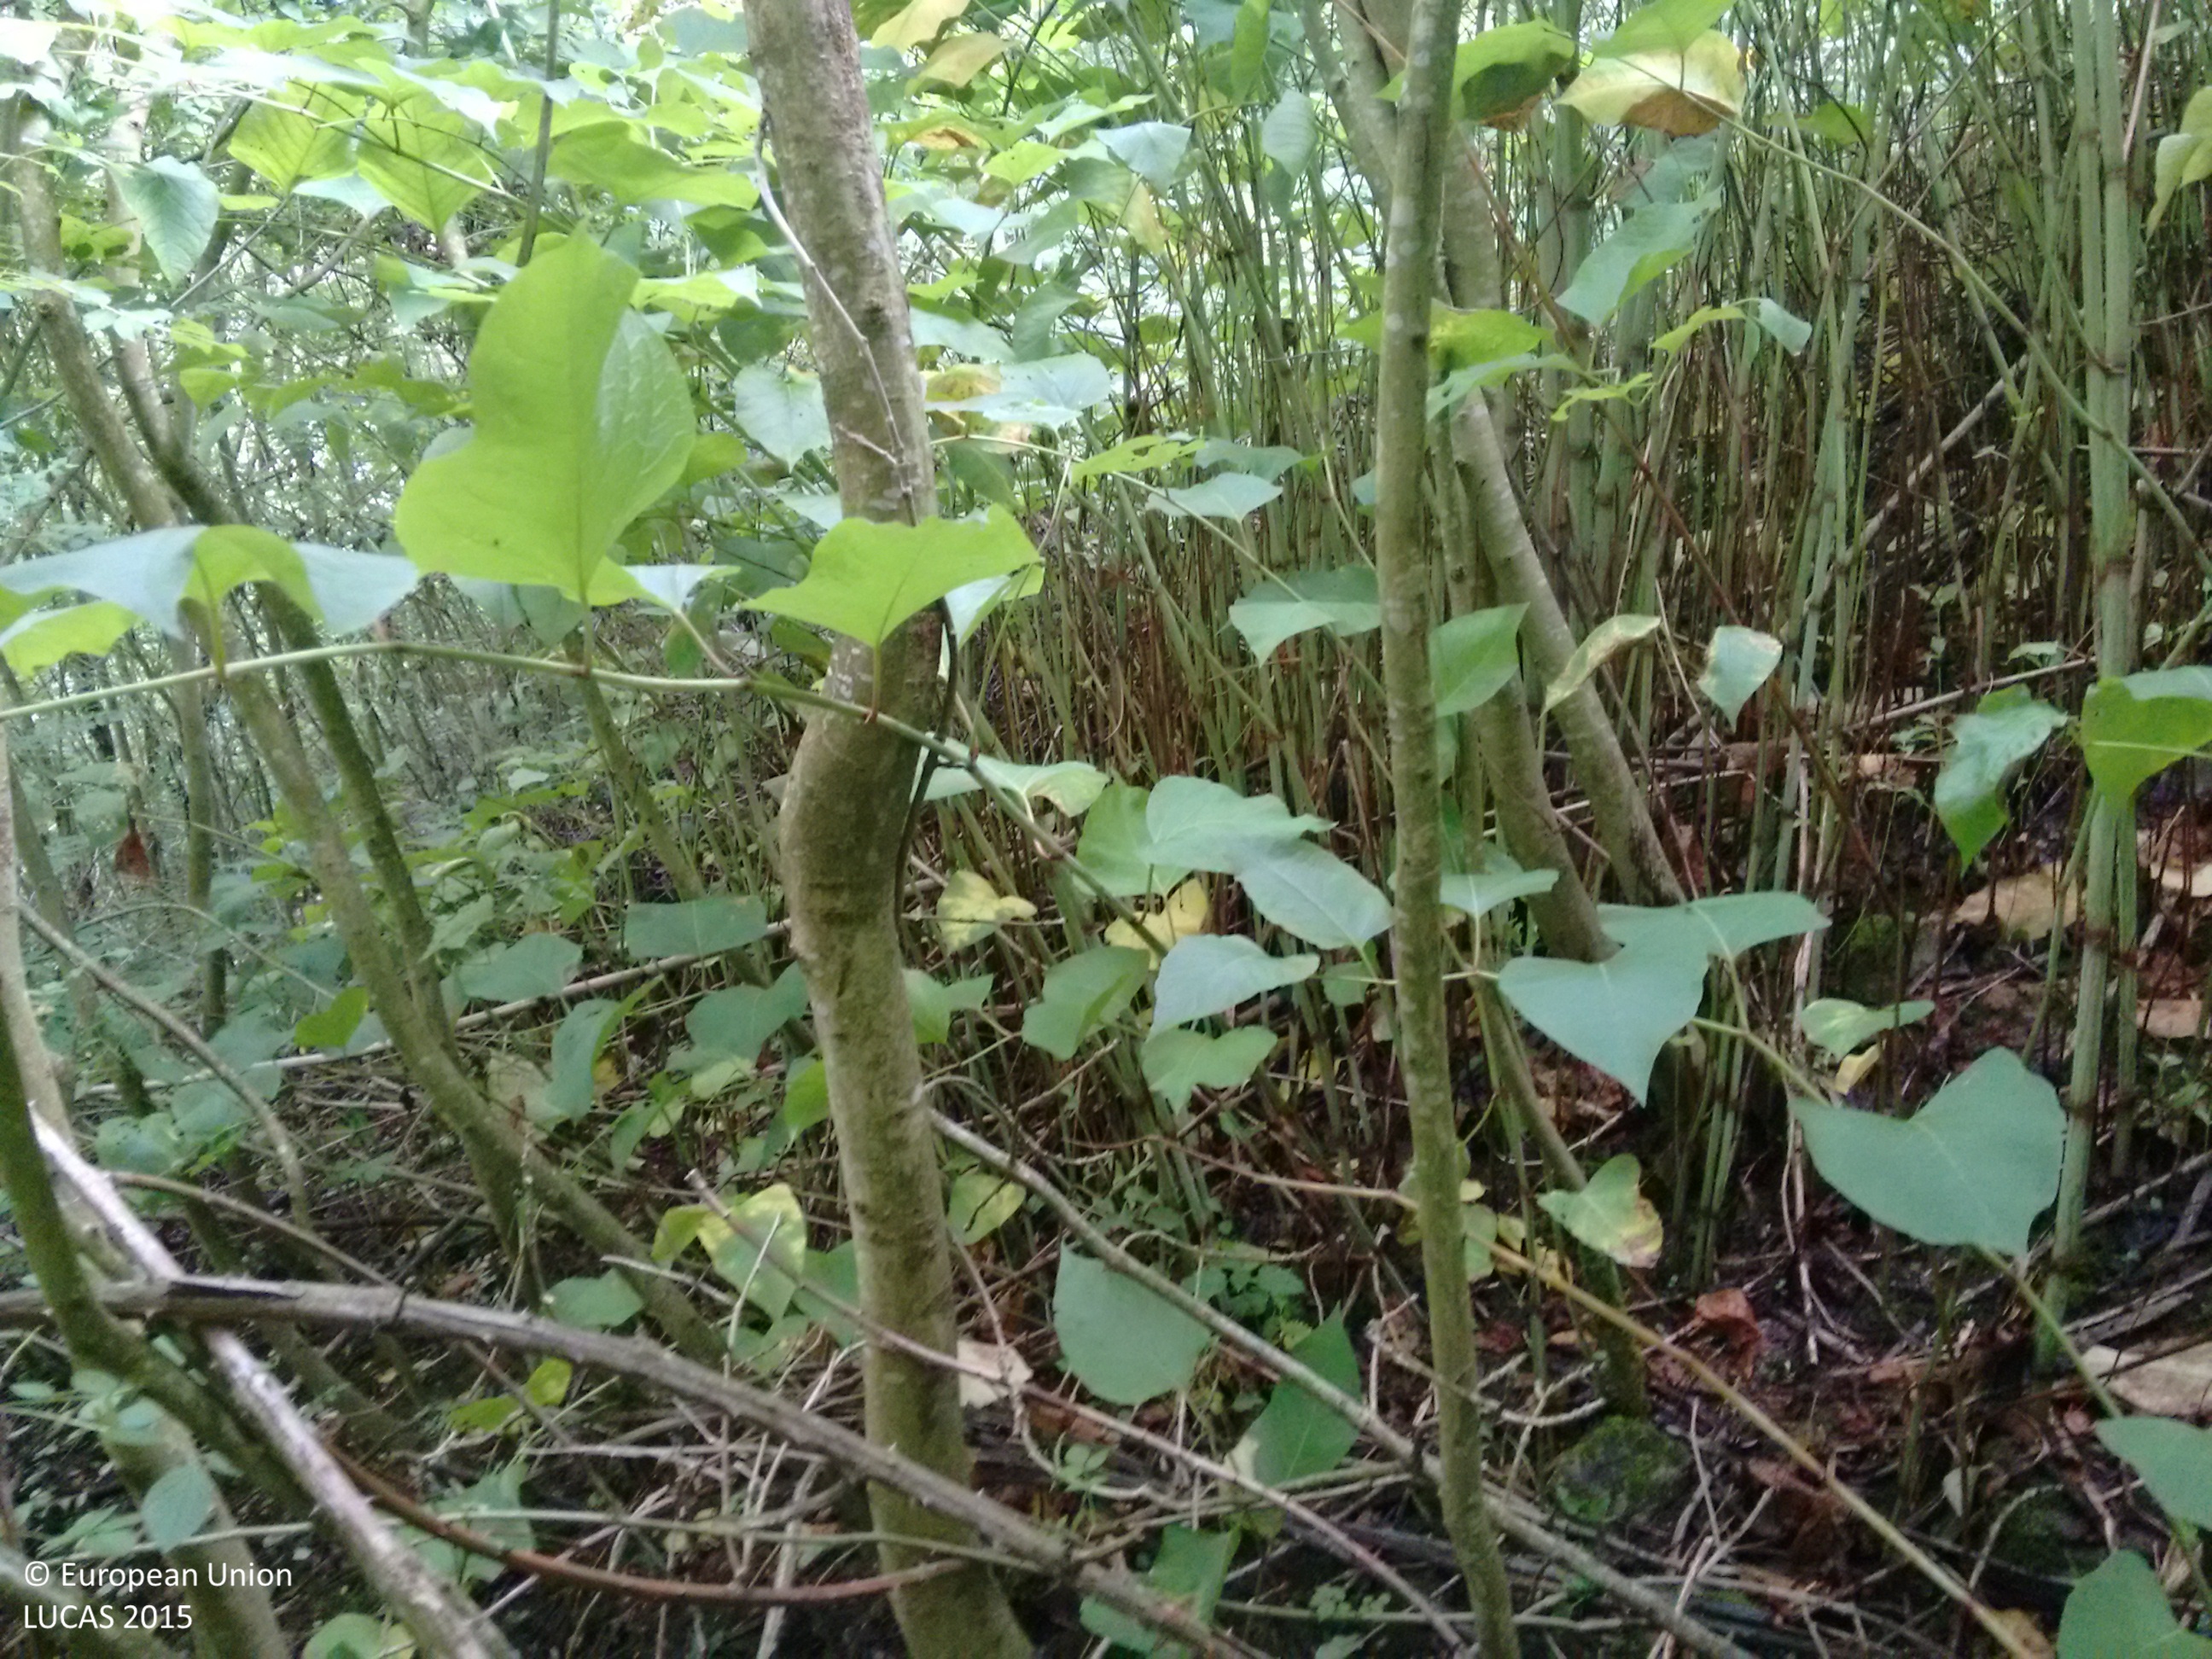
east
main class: Woodland
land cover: Broadleaved woodland
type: mesophytic deciduous forest
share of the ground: > 75 %
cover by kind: broadleaved forest trees 100 %
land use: Semi-natural and natural areas not in use
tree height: > 5 m
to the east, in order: Broadleaved woodland; Tracks; Broadleaved woodland; Tracks; Inland fresh running water; Broadleaved woodland; Tracks; Broadleaved woodland; Dry stone walls; Fences; Tracks; Broadleaved woodland; Dry stone walls; Broadleaved woodland; Dry stone walls; Artificial constructions in urban areas
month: July
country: GB
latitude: 51.5131
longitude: -2.5020
